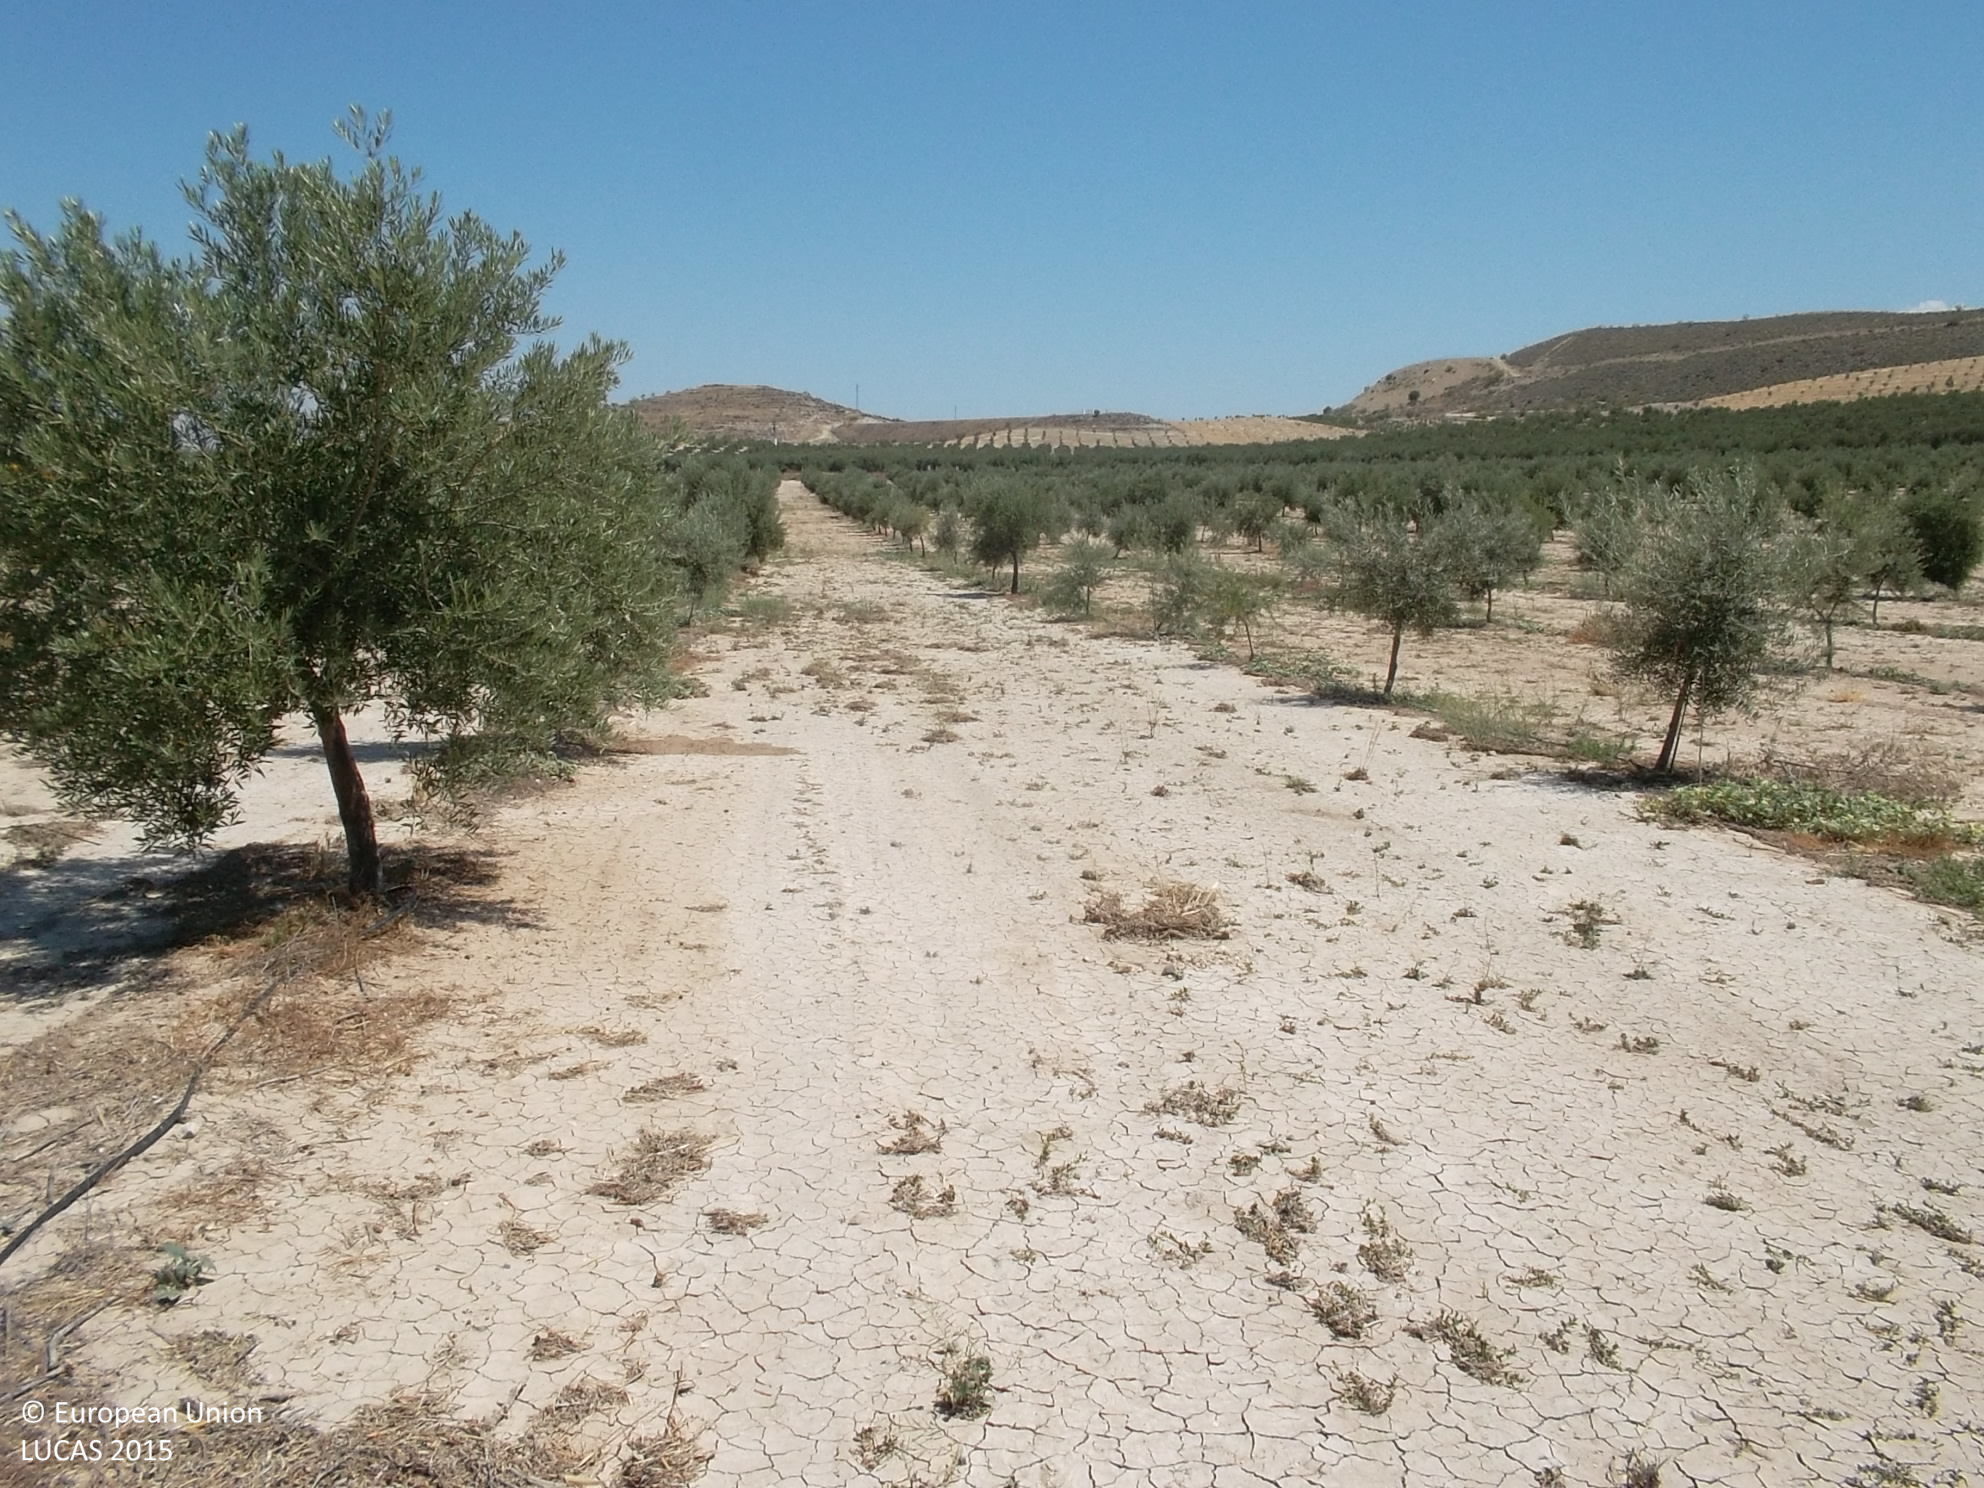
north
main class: Cropland
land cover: Olive groves
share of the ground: 25 - 50 %
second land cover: Other bare soil
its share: > 75 %
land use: Agriculture (excluding fallow land and kitchen gardens)
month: June
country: ES
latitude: 37.8454
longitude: -3.2354
